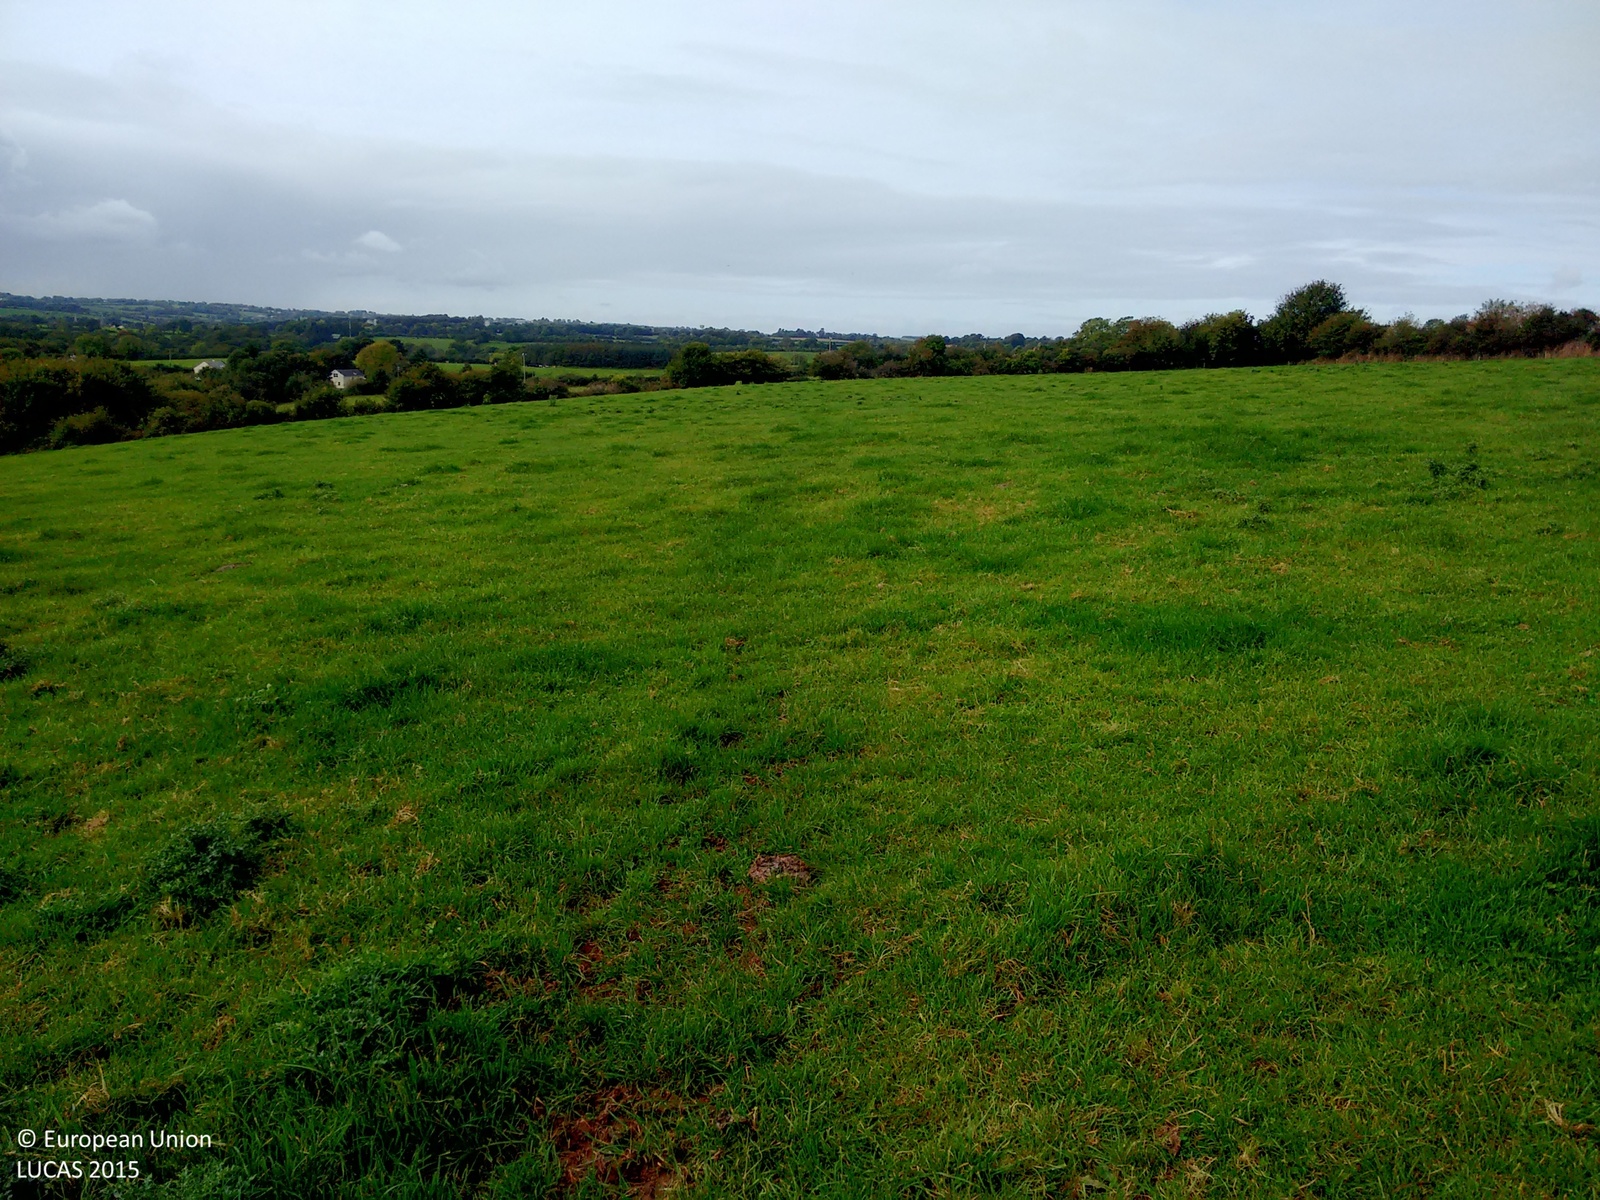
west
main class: Grassland
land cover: Grassland without tree/shrub cover
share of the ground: > 75 %
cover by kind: herbaceous plants 100 %
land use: Agriculture (excluding fallow land and kitchen gardens)
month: October
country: IE
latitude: 51.9602
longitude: -8.3657
